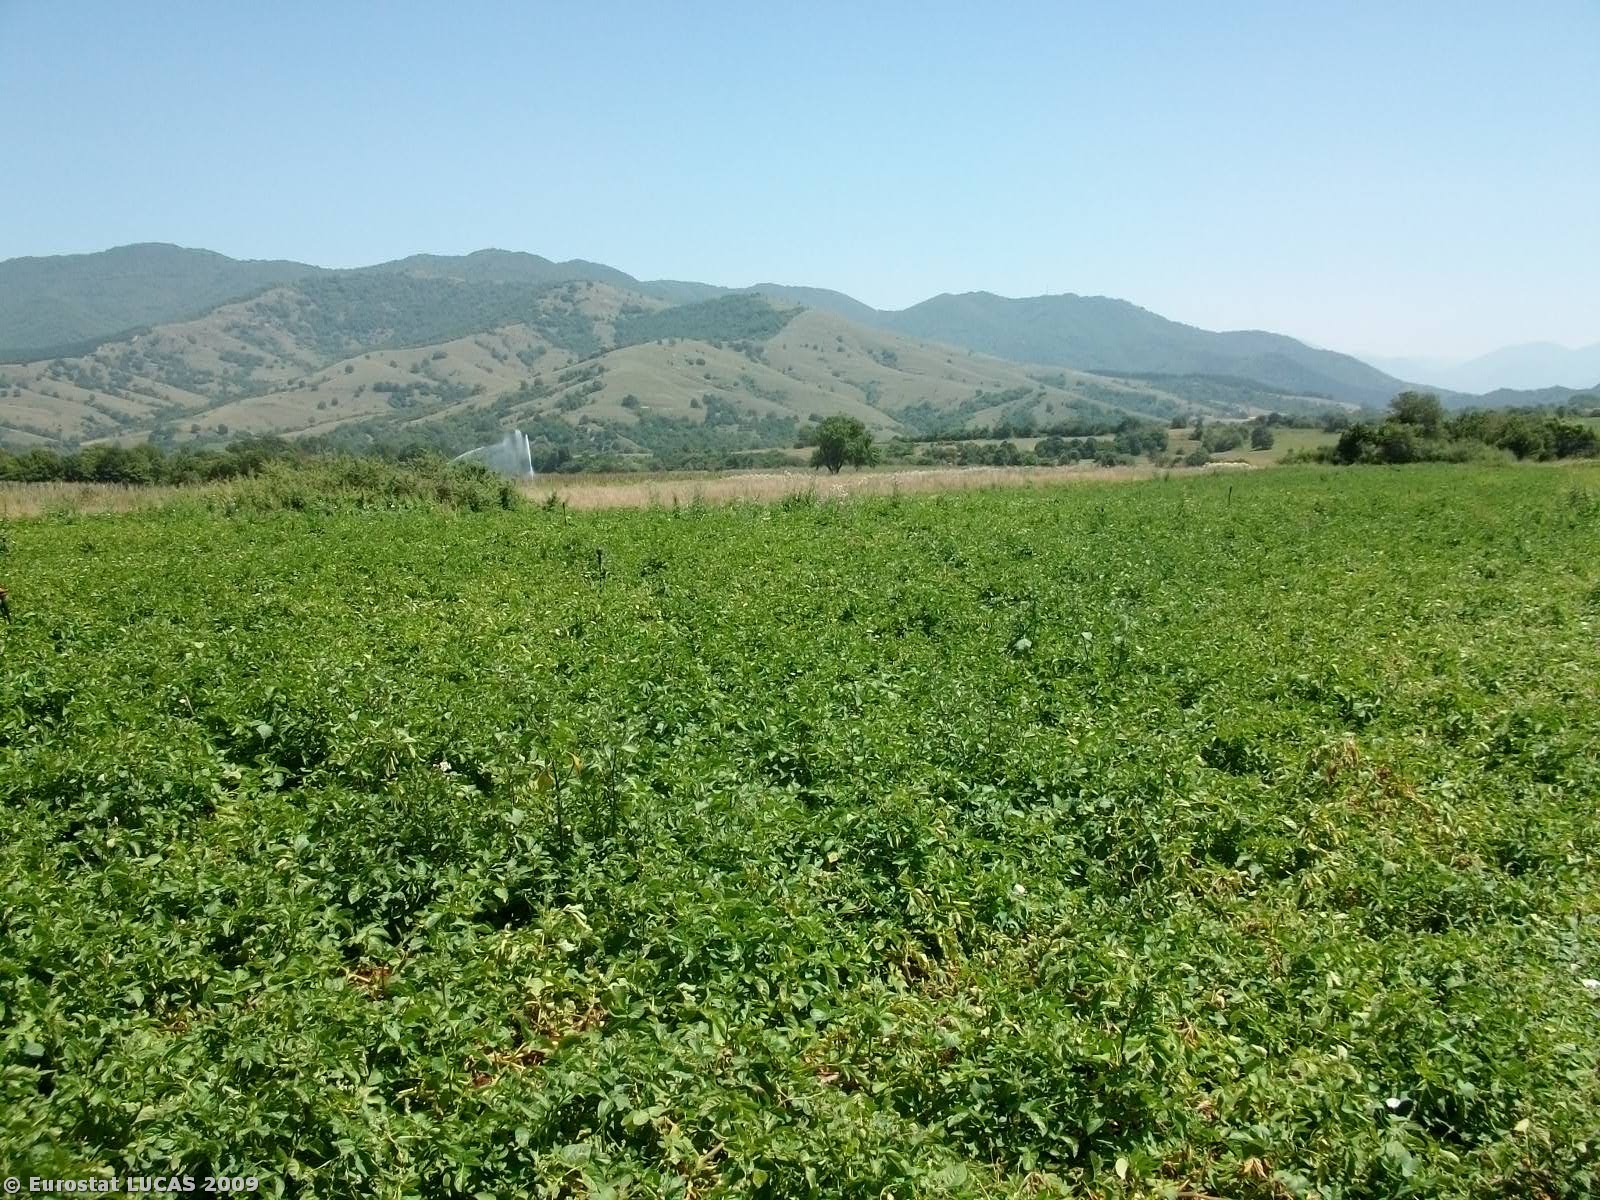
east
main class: Cropland
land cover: Potatoes
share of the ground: > 75 %
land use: Agriculture (excluding fallow land and kitchen gardens)
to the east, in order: Potatoes; Grass margins; Tracks; Durum wheat; Grass margins; Dry pulses
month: July
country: GR
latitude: 41.3685
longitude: 23.7145
